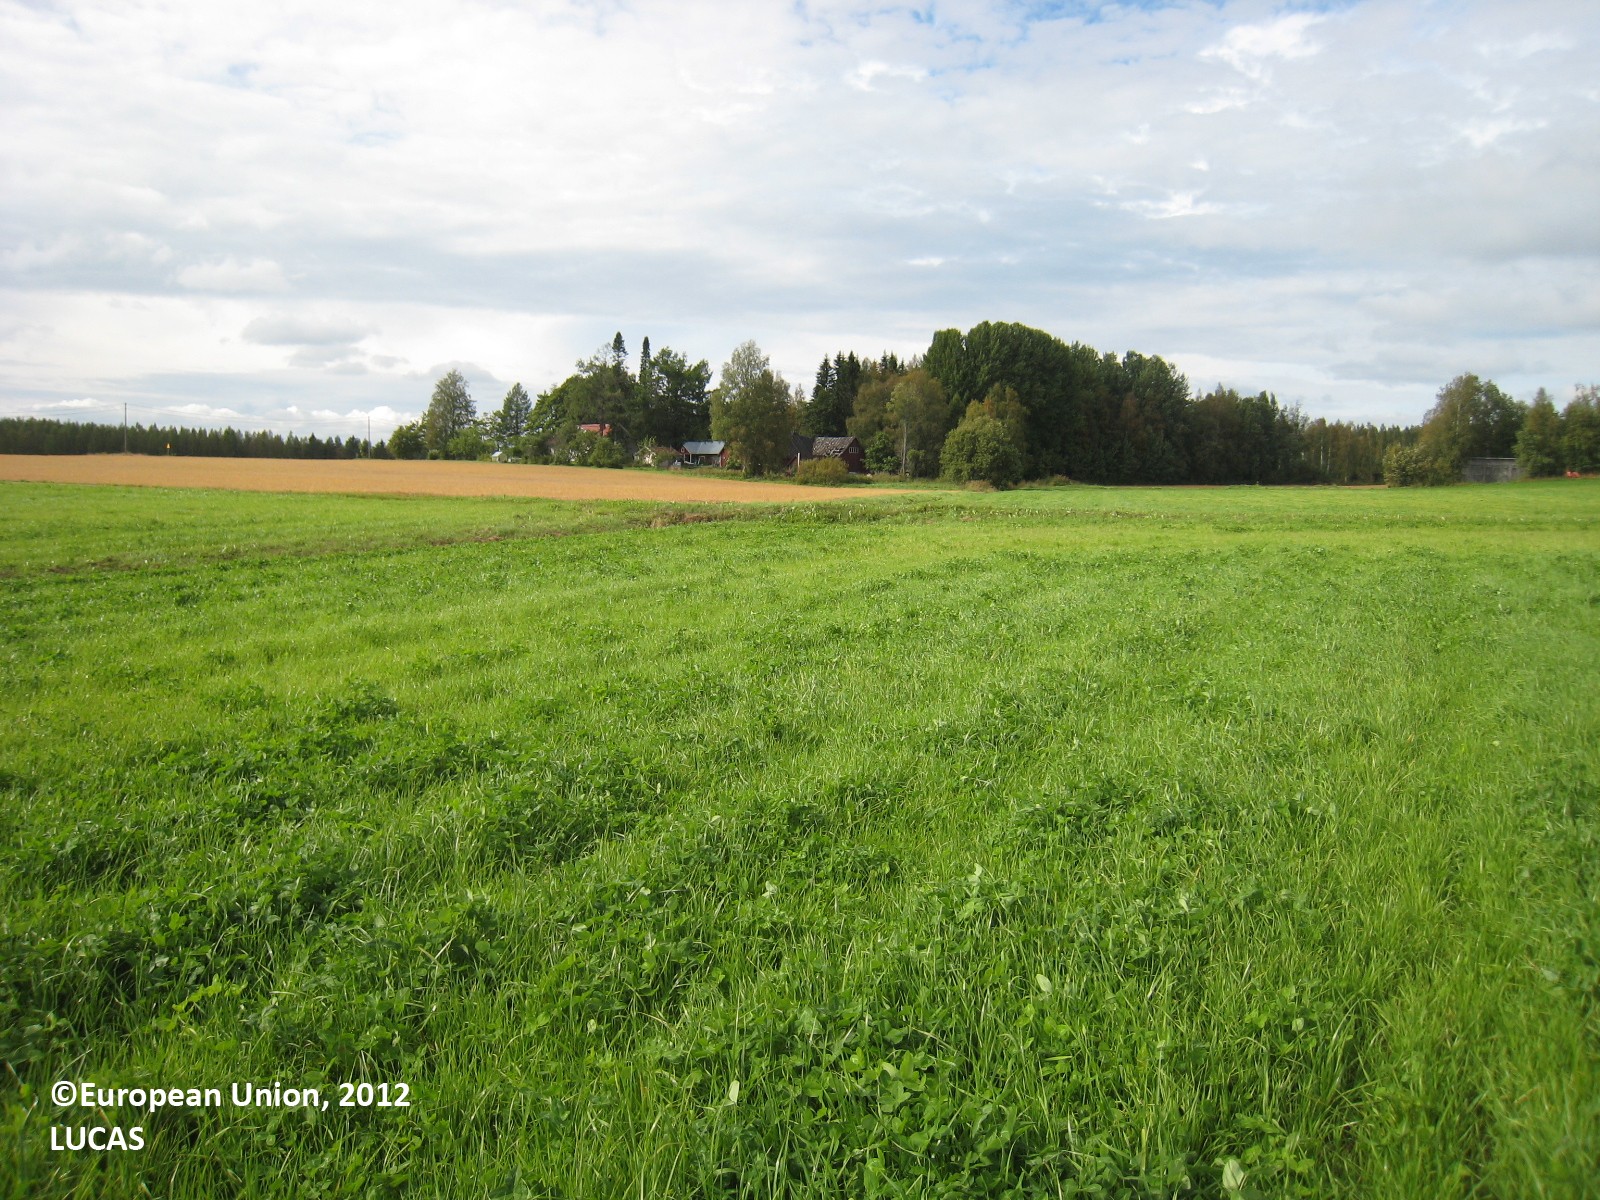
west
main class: Cropland
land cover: Temporary grasslands
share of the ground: > 75 %
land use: Agriculture (excluding fallow land and kitchen gardens)
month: August
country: FI
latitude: 62.2111
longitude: 27.2951
